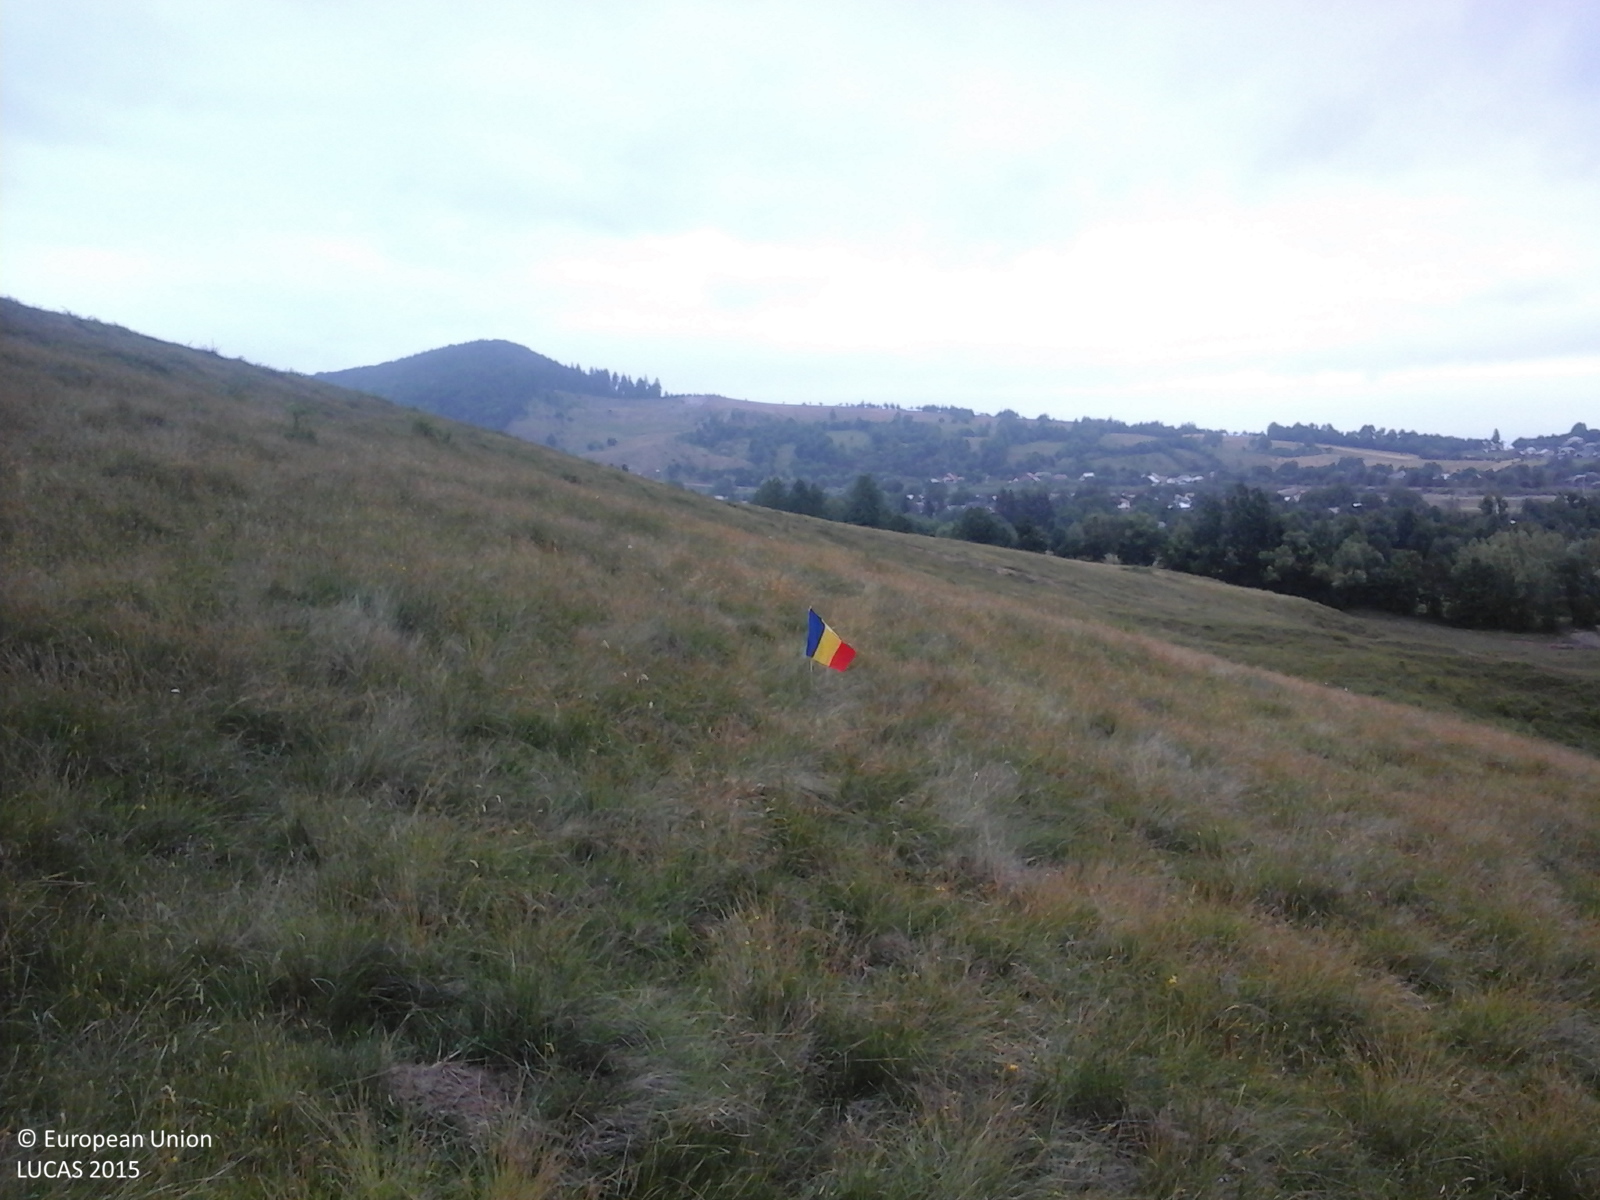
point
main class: Grassland
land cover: Grassland without tree/shrub cover
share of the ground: > 75 %
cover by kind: herbaceous plants 100 %
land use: Agriculture (excluding fallow land and kitchen gardens)
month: June
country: RO
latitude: 47.0917
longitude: 26.2975
